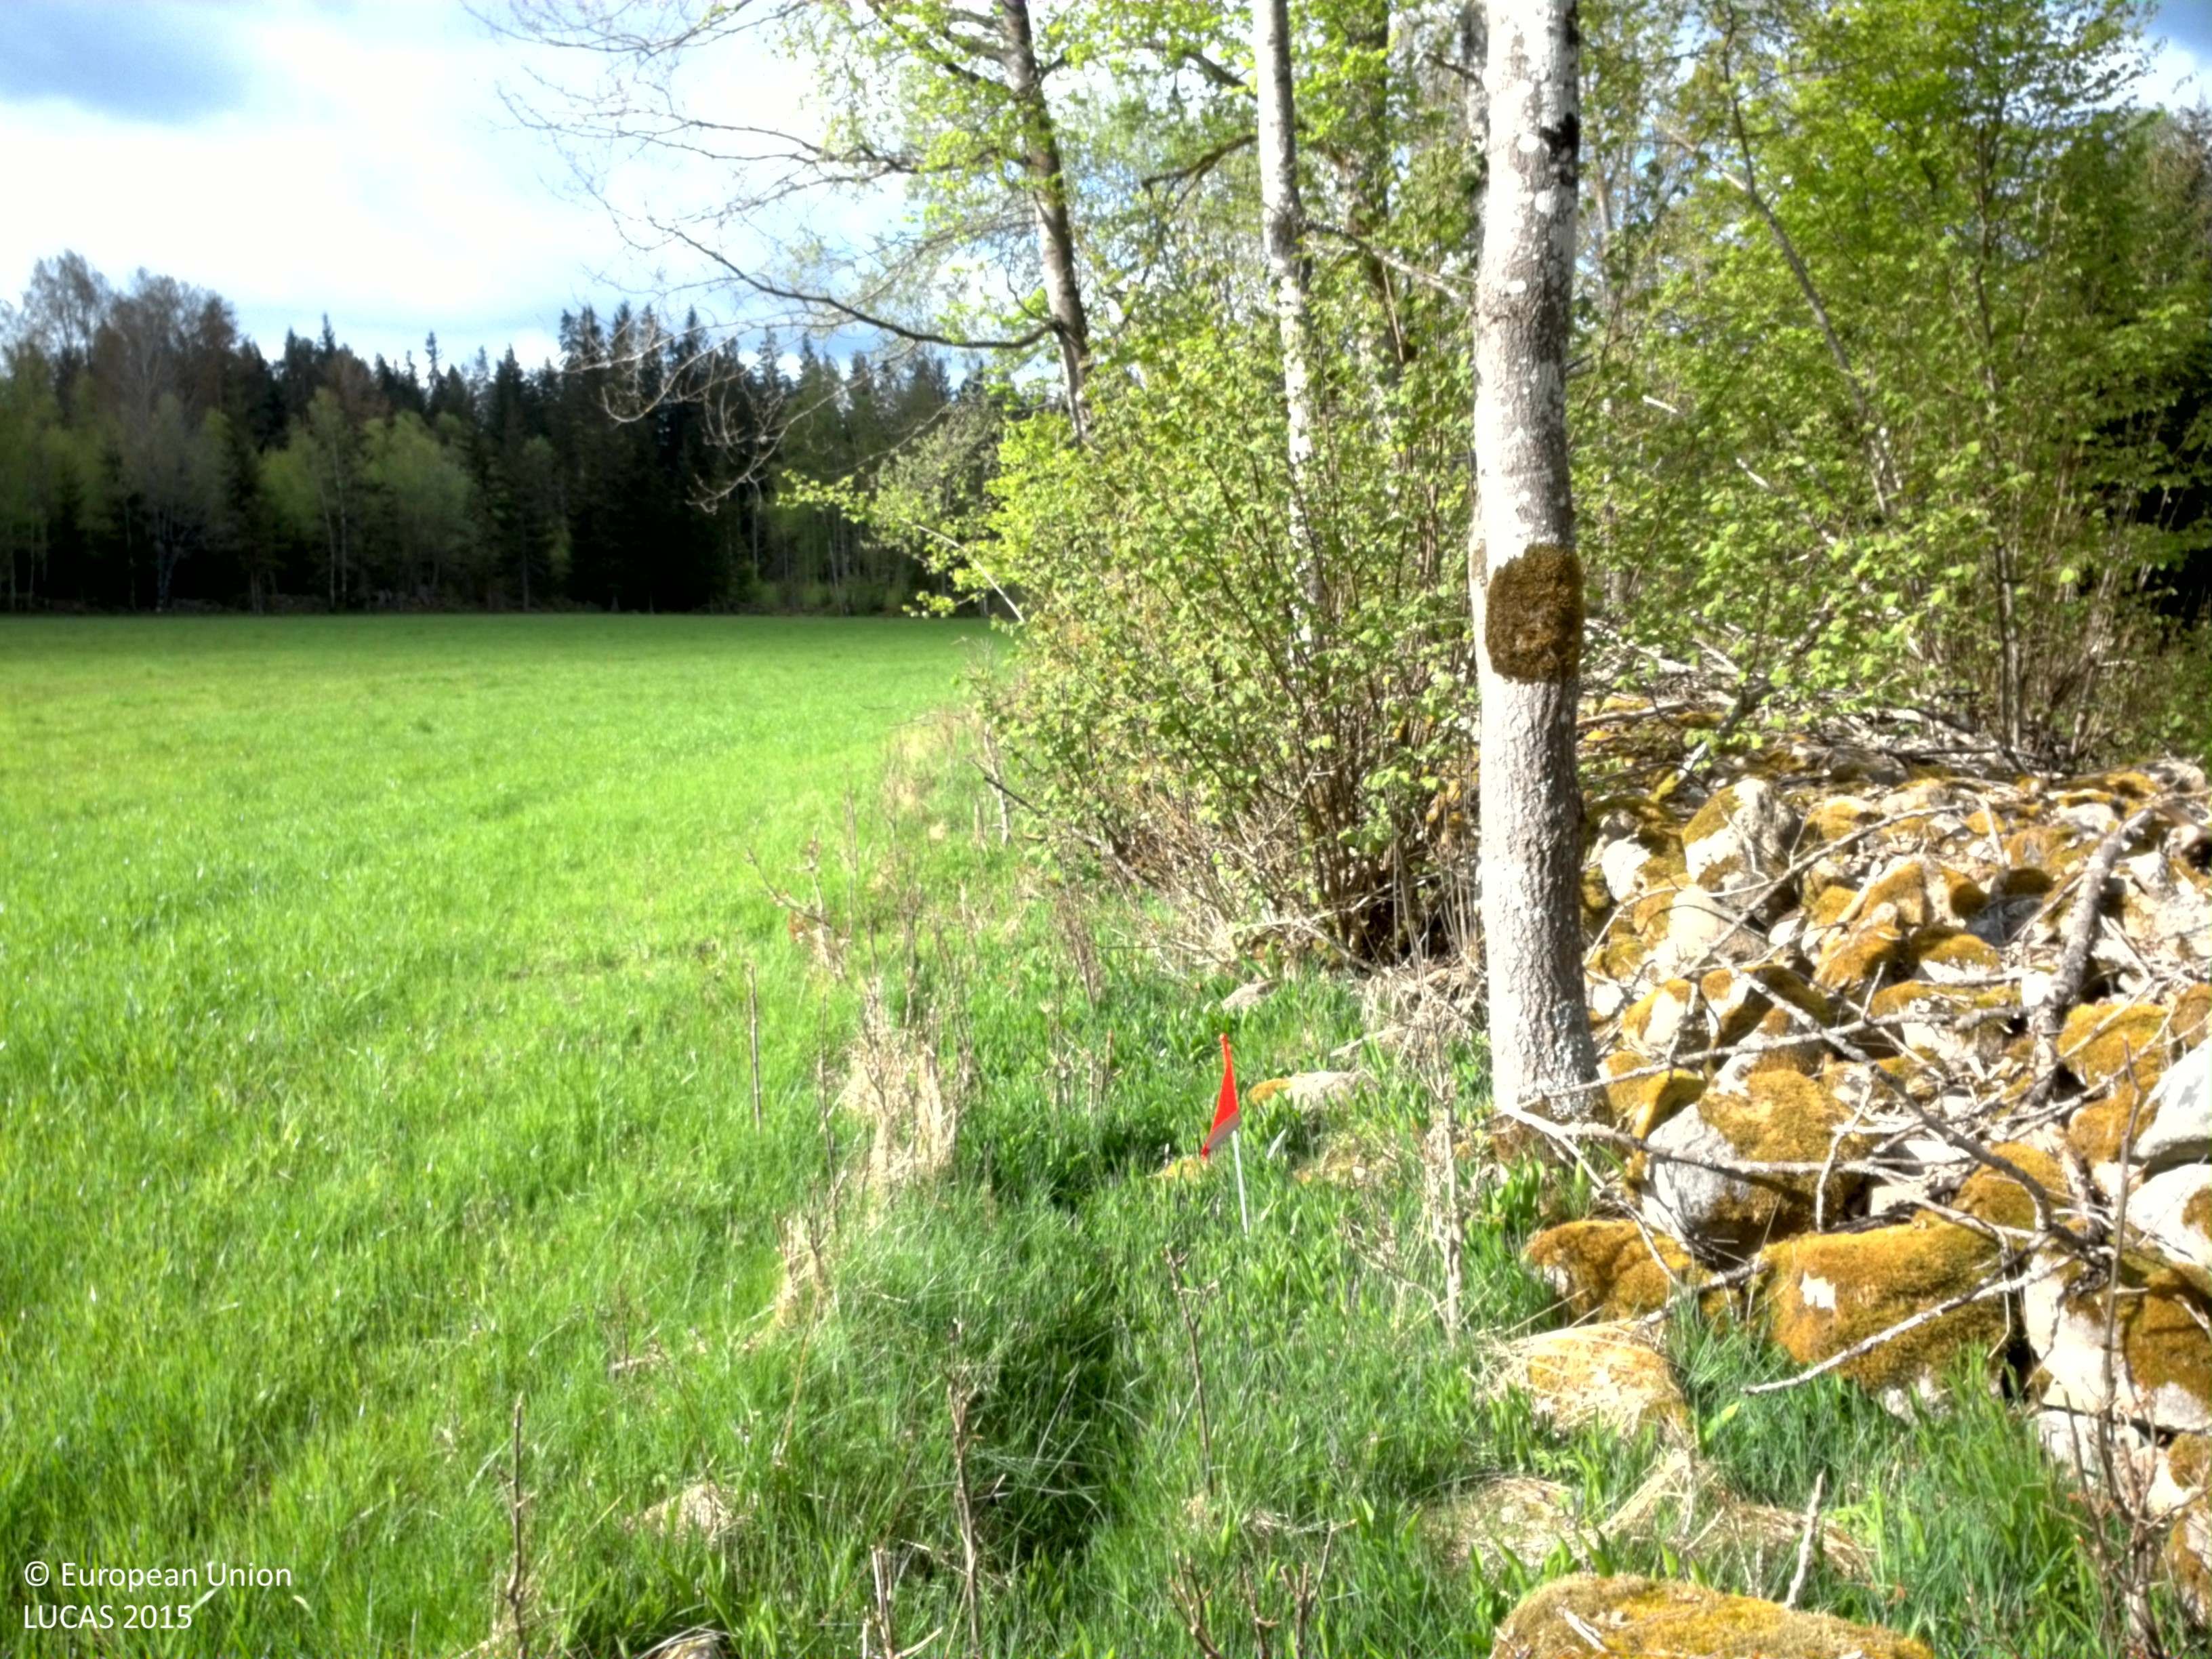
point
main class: Woodland
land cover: Broadleaved woodland
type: boreal forest
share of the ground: 50 - 75 %
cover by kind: broadleaved forest trees 50 %, herbaceous plants 30 %, coniferous forest trees 10 %, lichens and mosses 10 %
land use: Forestry
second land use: Amenities, museums, leisure
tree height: > 5 m
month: May
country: SE
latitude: 56.6537
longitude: 15.3322
